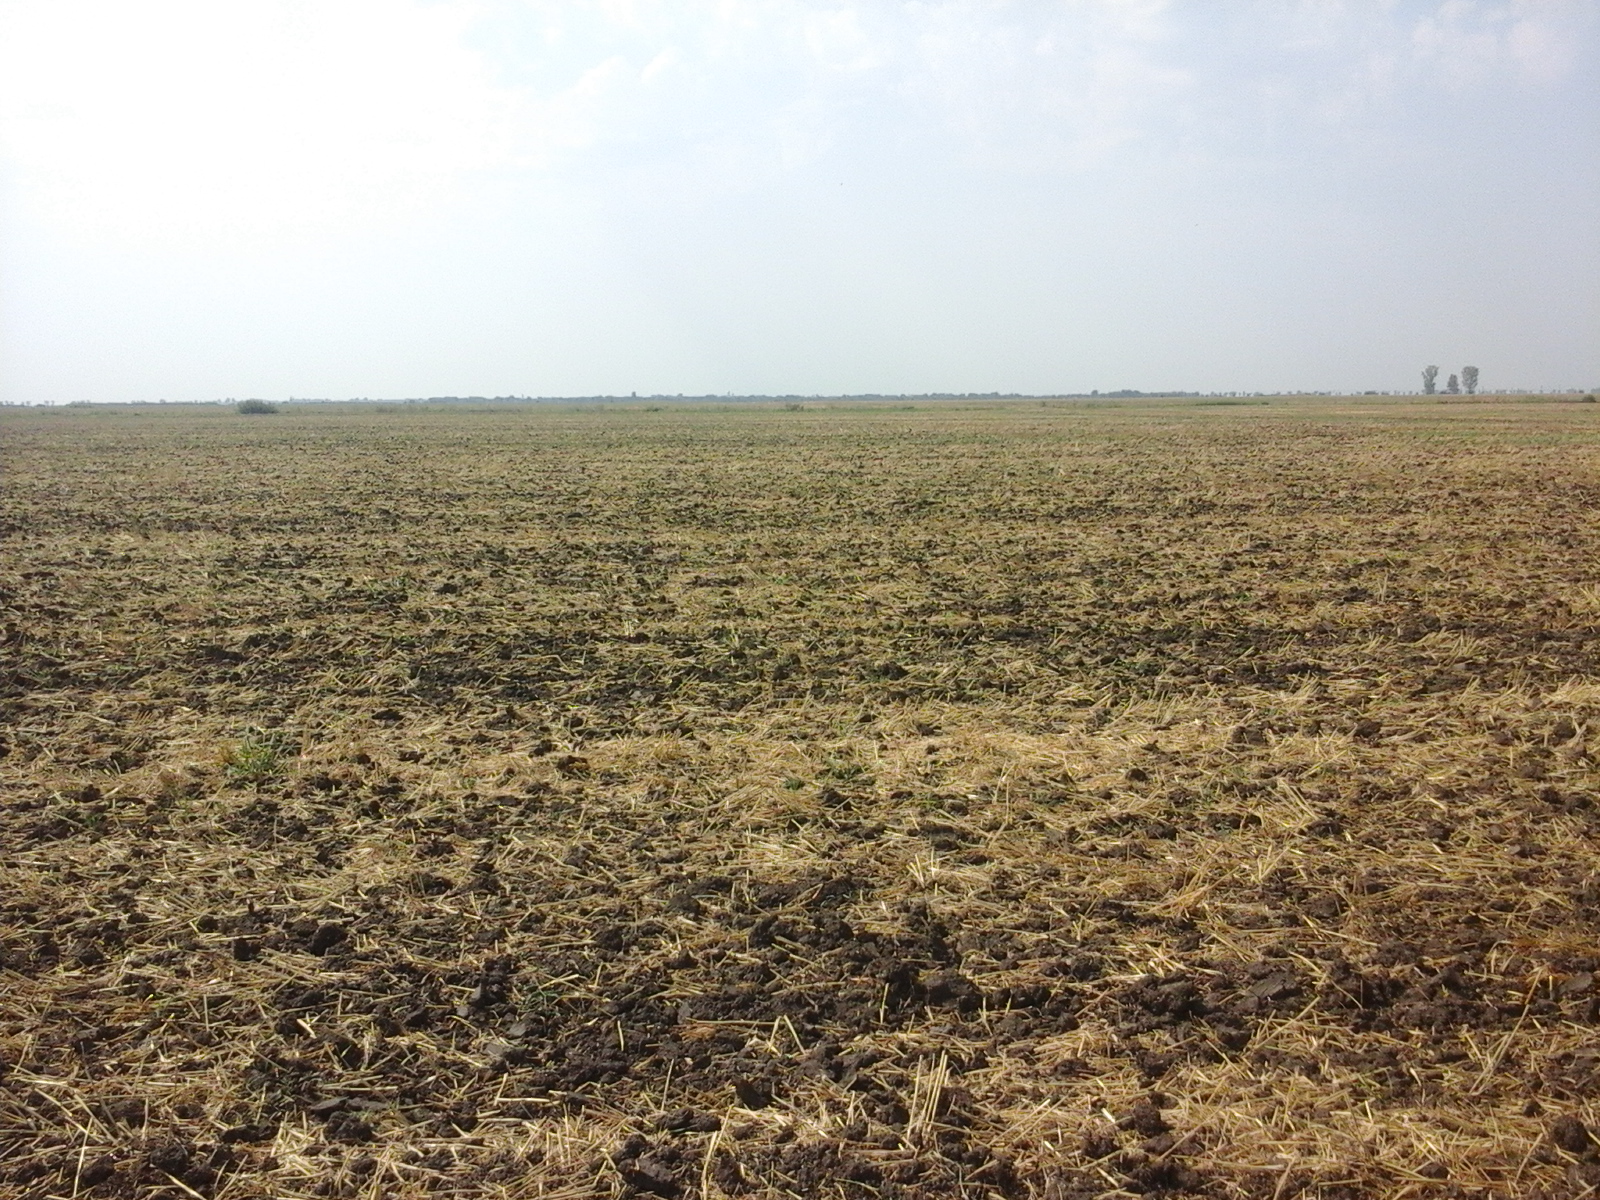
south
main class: Cropland
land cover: Common wheat
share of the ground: 50 - 75 %
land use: Agriculture (excluding fallow land and kitchen gardens)
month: August
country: RO
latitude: 44.0429
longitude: 23.5409
